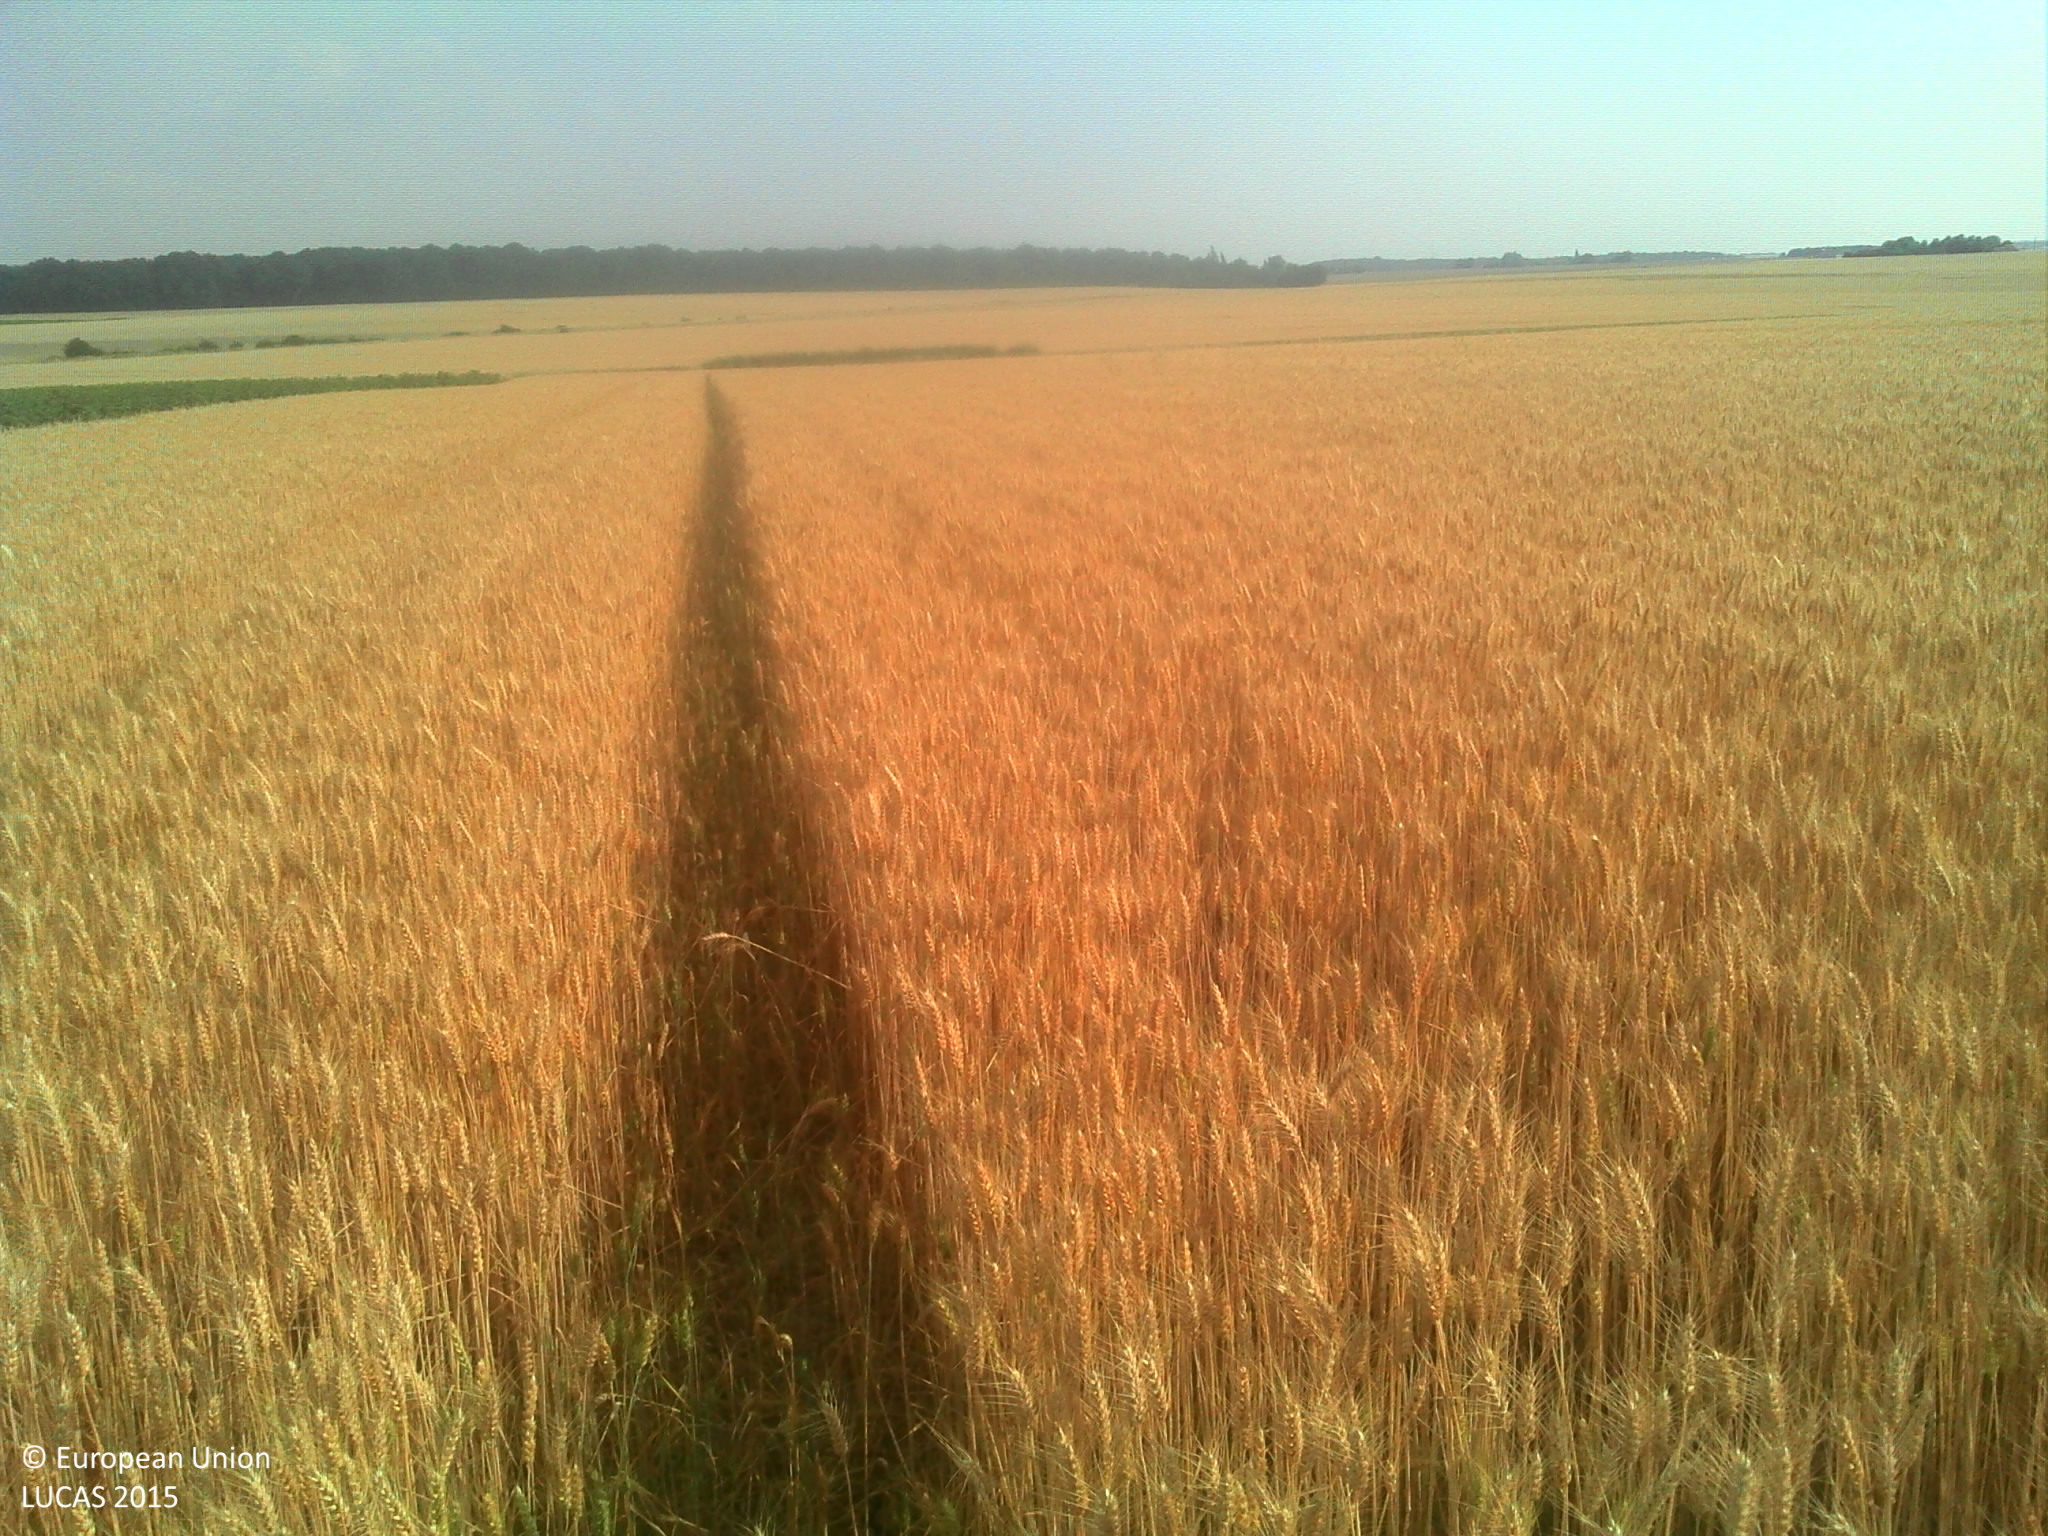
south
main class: Cropland
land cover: Durum wheat
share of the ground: > 75 %
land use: Agriculture (excluding fallow land and kitchen gardens)
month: July
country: FR
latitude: 47.6439
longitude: 1.0772
